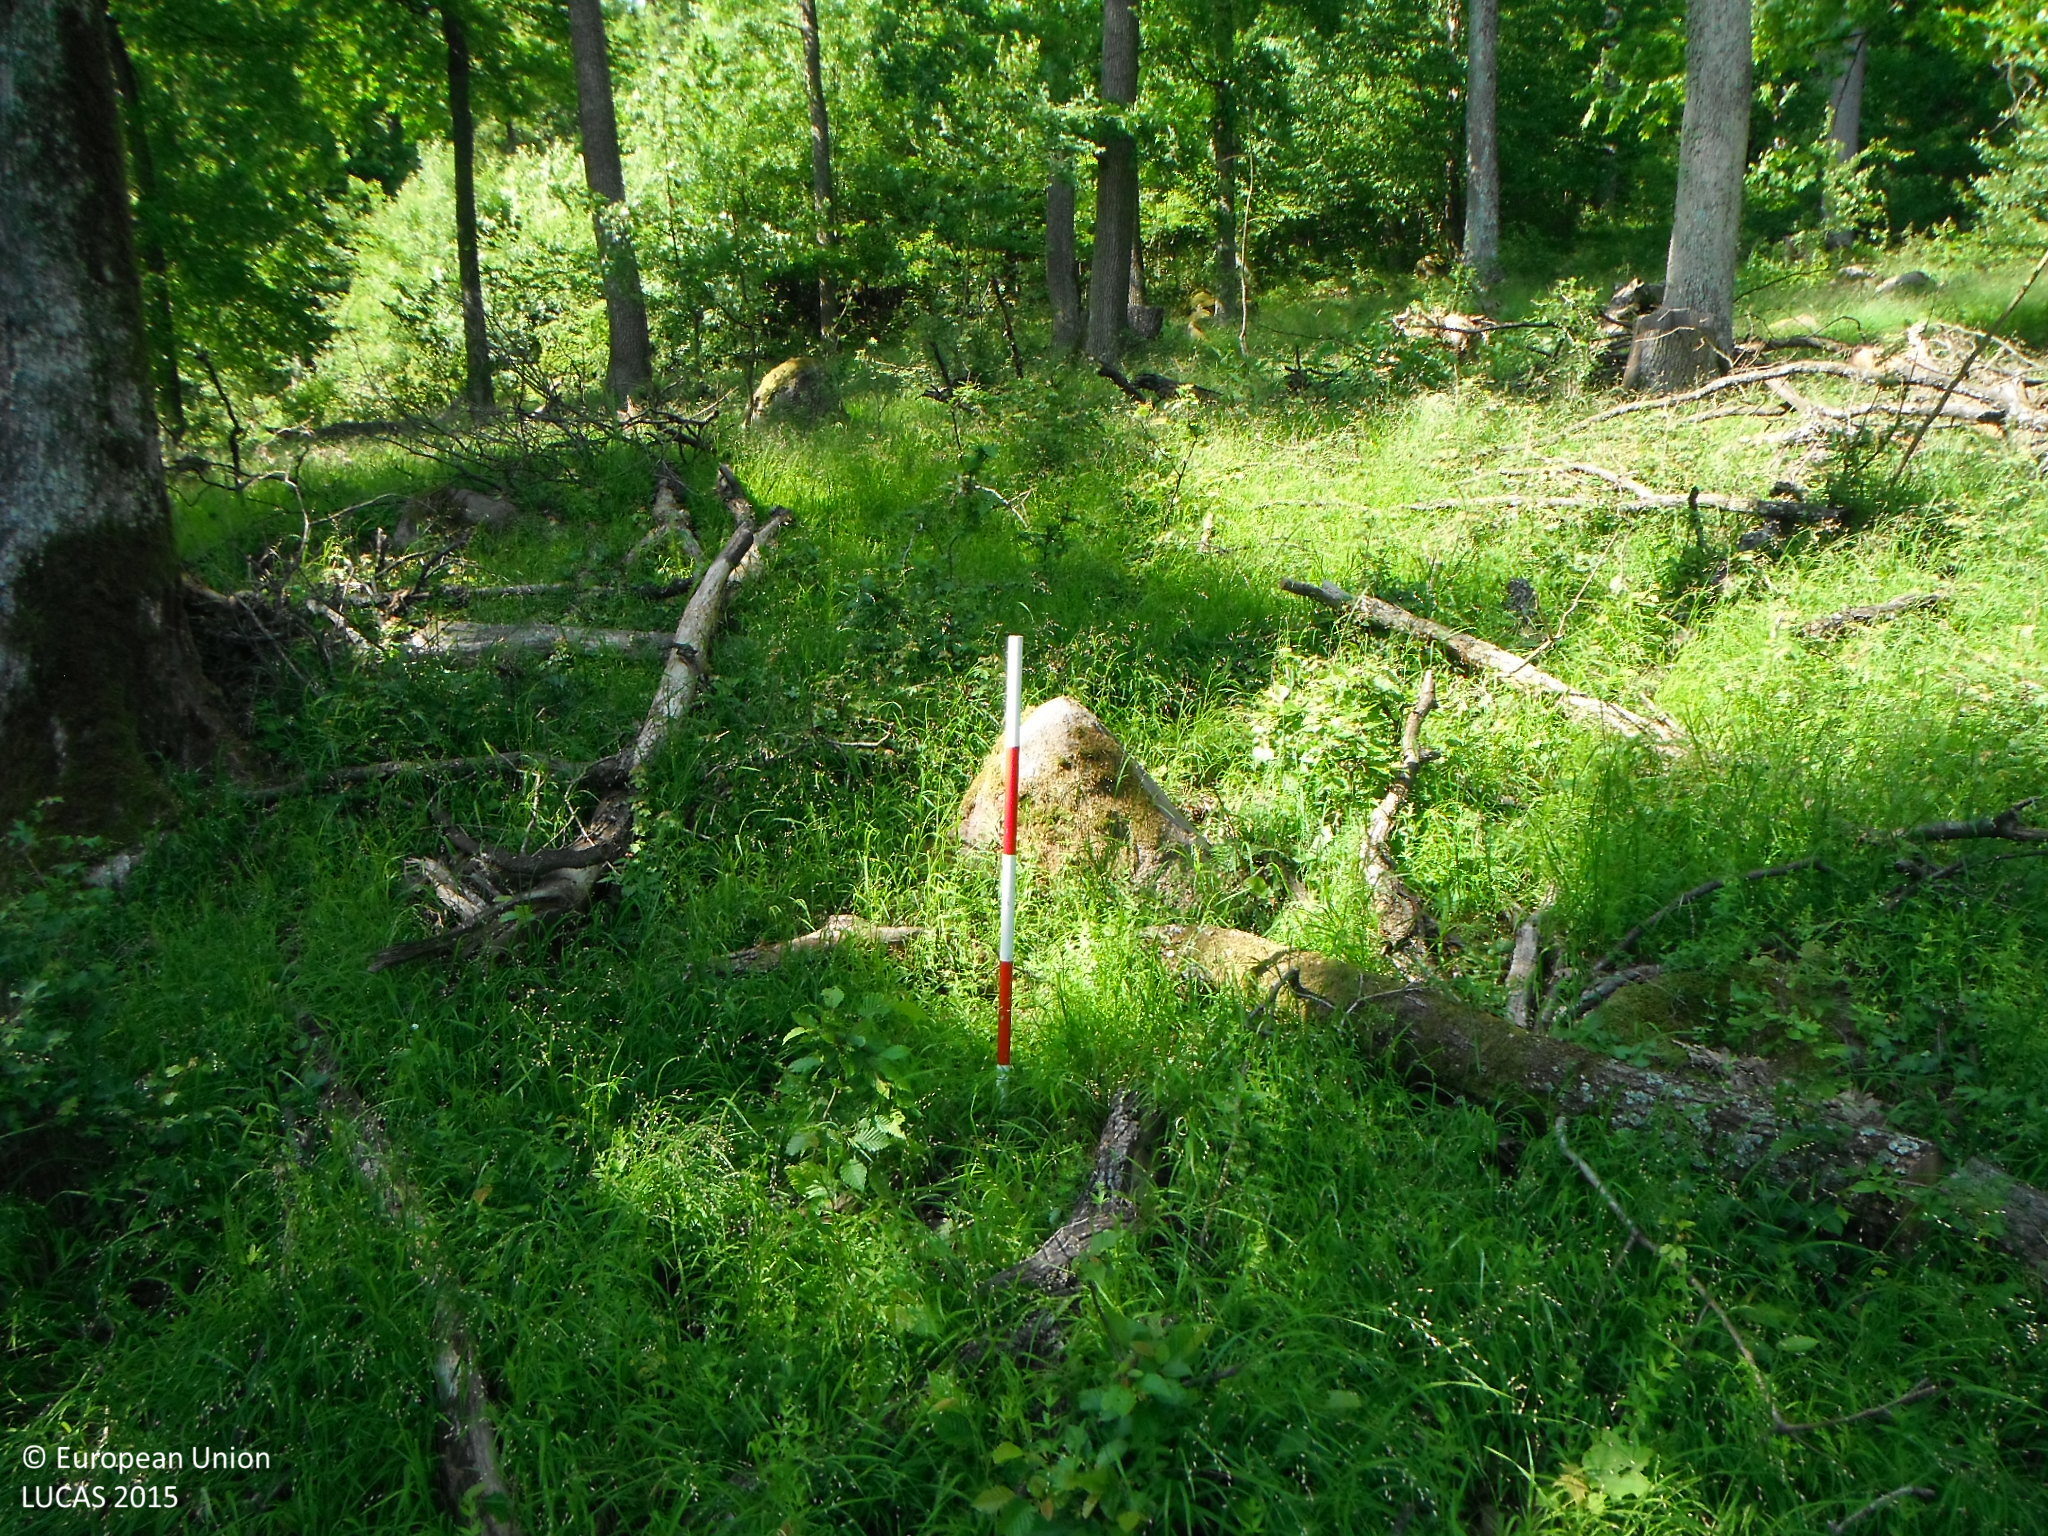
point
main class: Woodland
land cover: Broadleaved woodland
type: mesophytic deciduous forest
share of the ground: 50 - 75 %
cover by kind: broadleaved forest trees 75 %, herbaceous plants 25 %
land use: Forestry
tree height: > 5 m
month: May
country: SK
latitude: 48.3664
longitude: 18.9422
